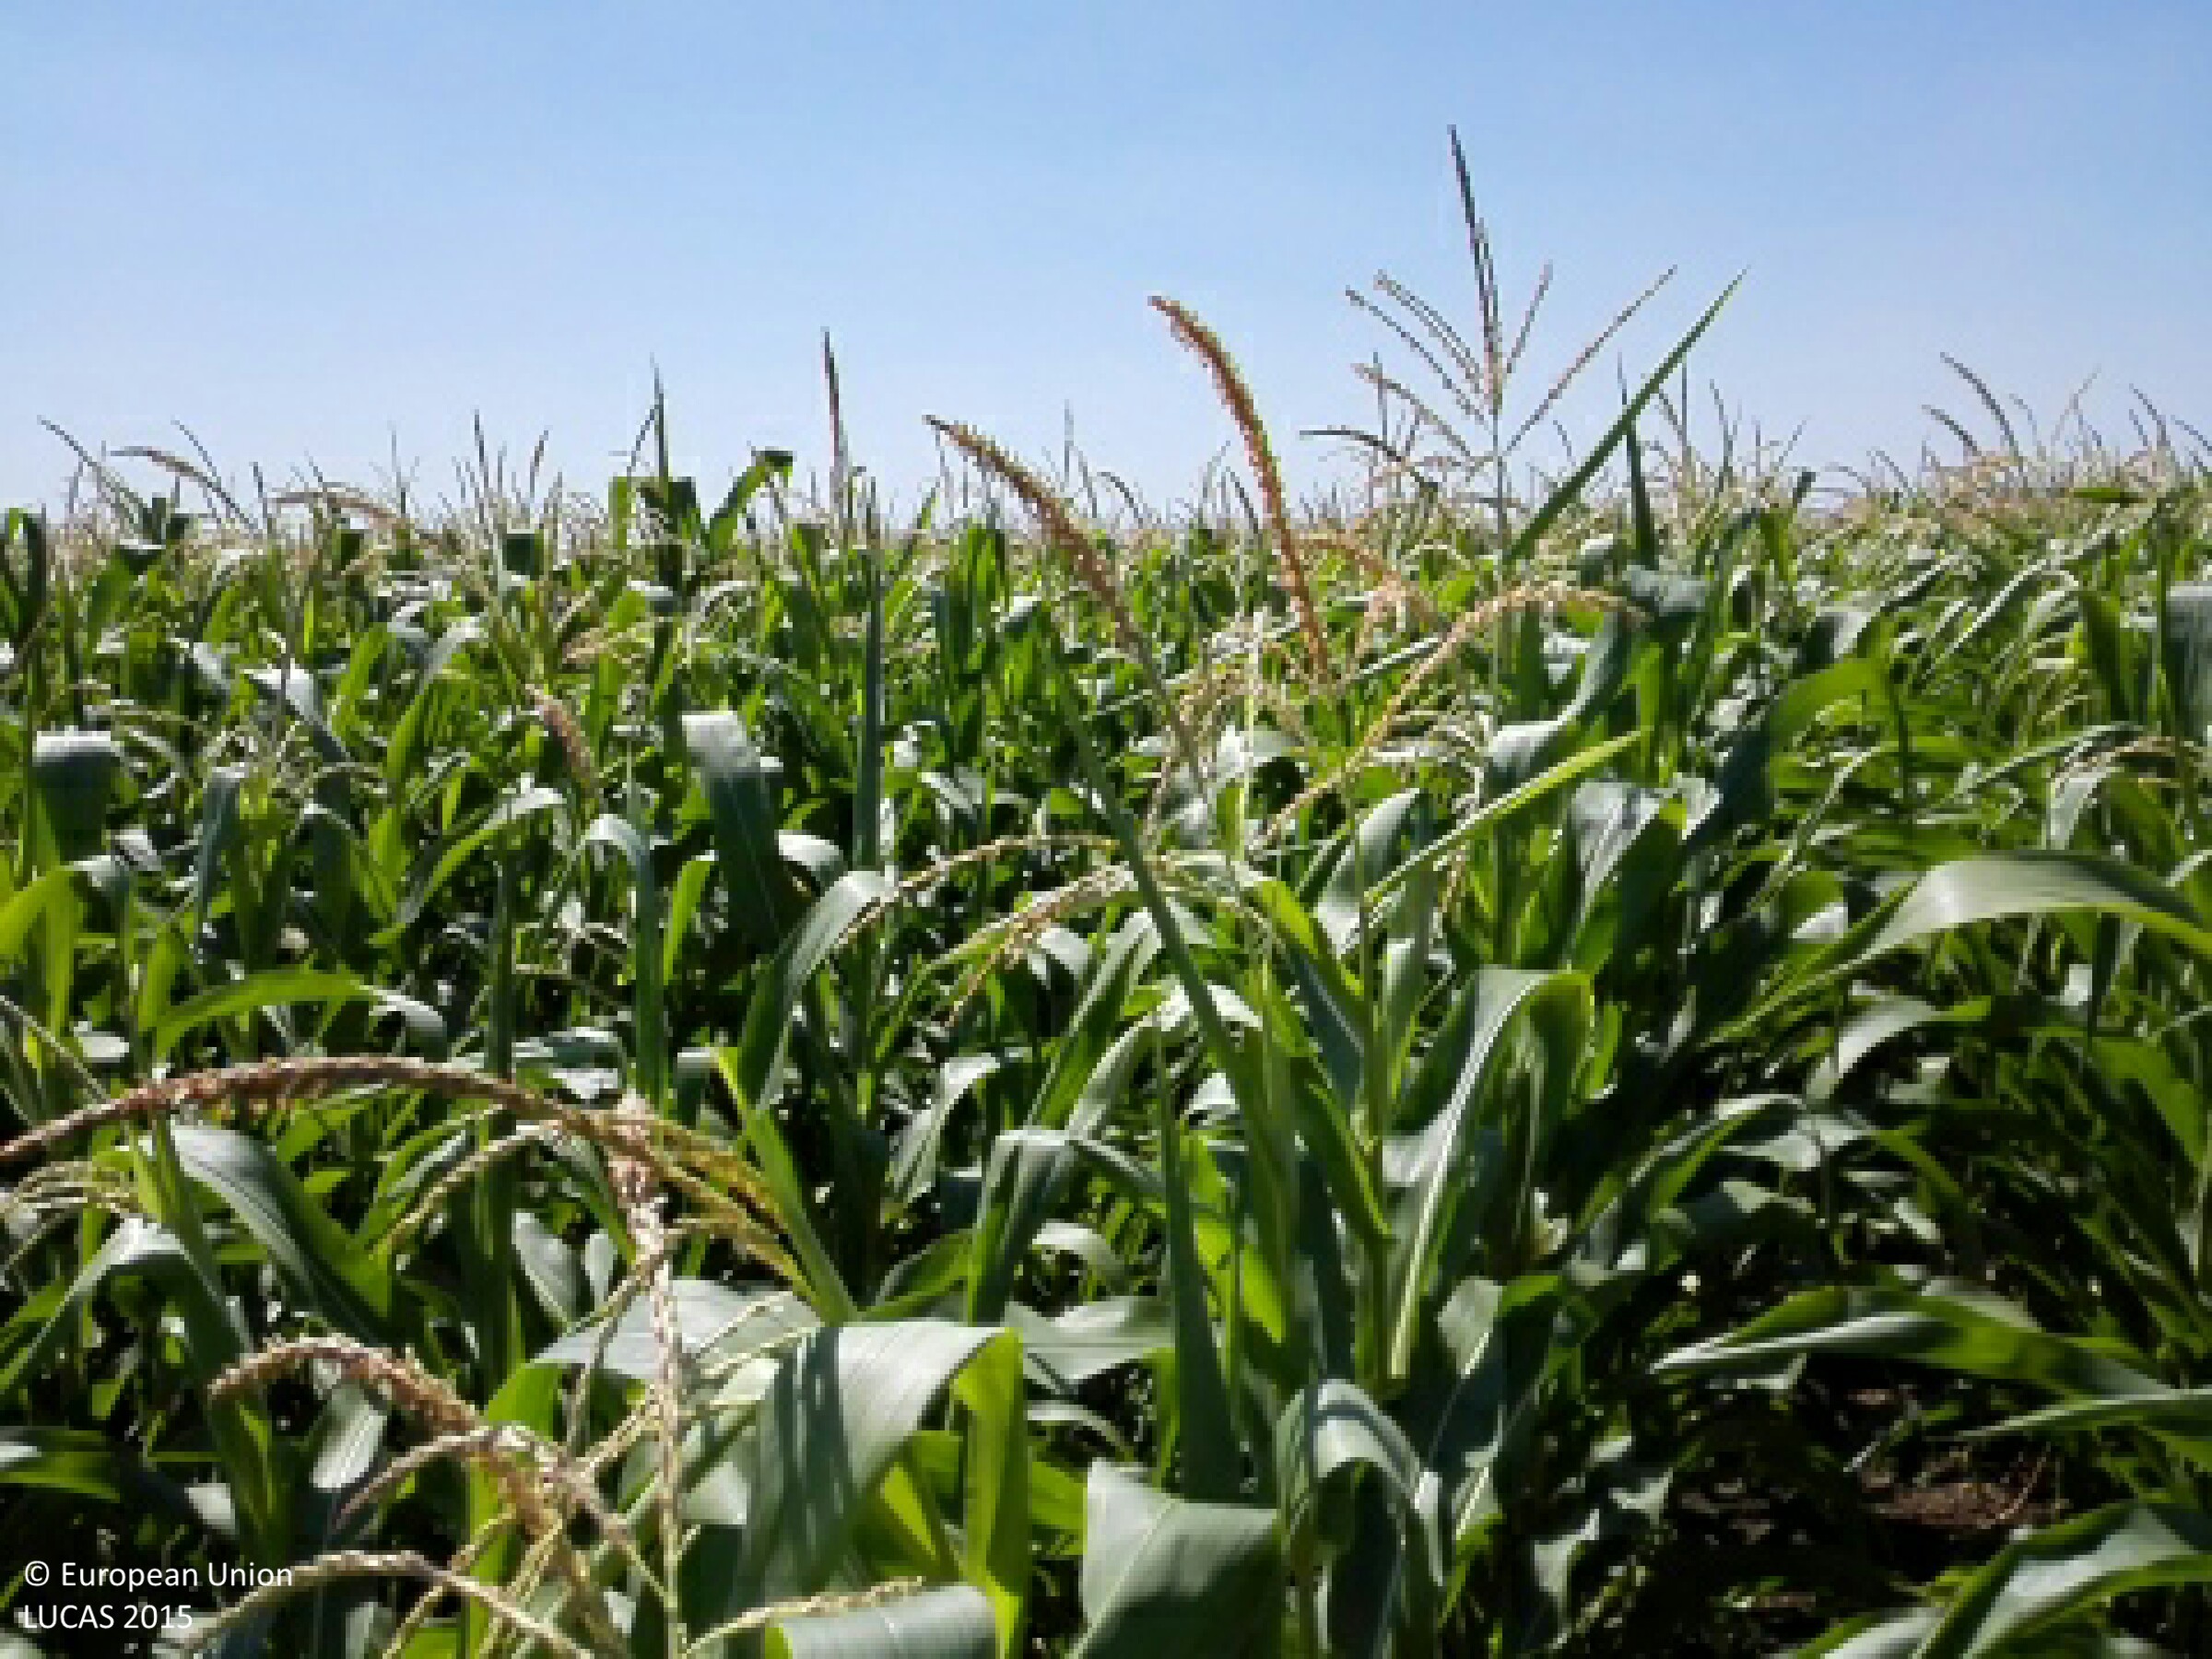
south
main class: Cropland
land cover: Maize
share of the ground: > 75 %
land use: Agriculture (excluding fallow land and kitchen gardens)
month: July
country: HU
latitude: 47.7755
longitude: 21.3994
